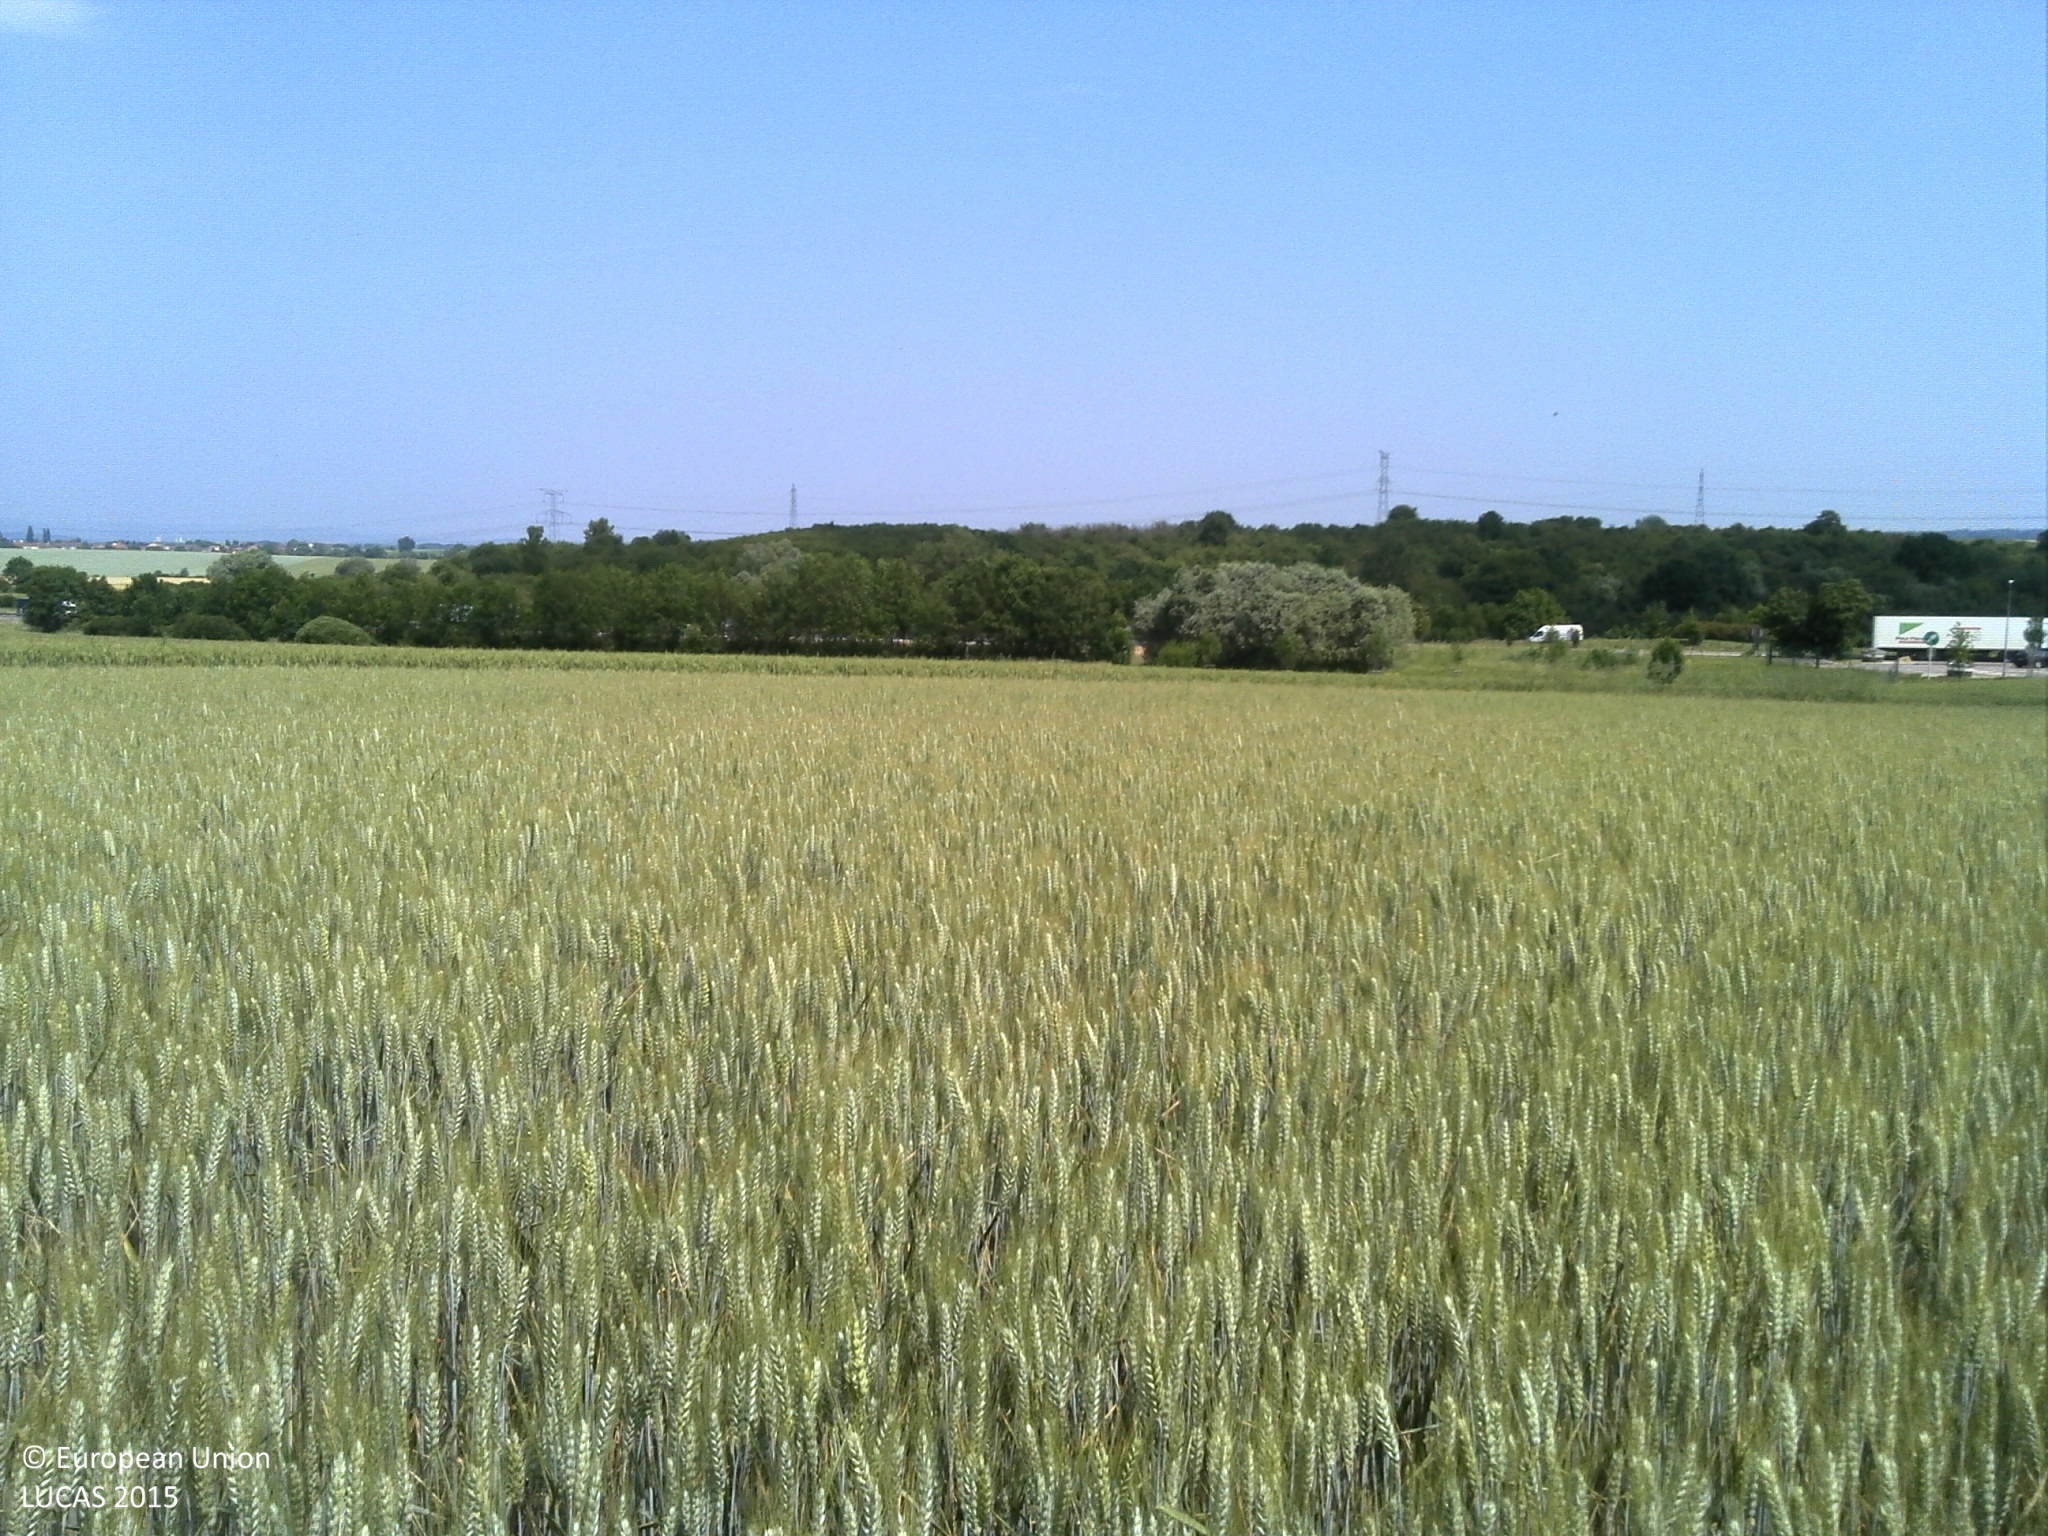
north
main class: Cropland
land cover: Common wheat
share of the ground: > 75 %
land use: Agriculture (excluding fallow land and kitchen gardens)
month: June
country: FR
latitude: 49.1856
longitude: 6.2267
